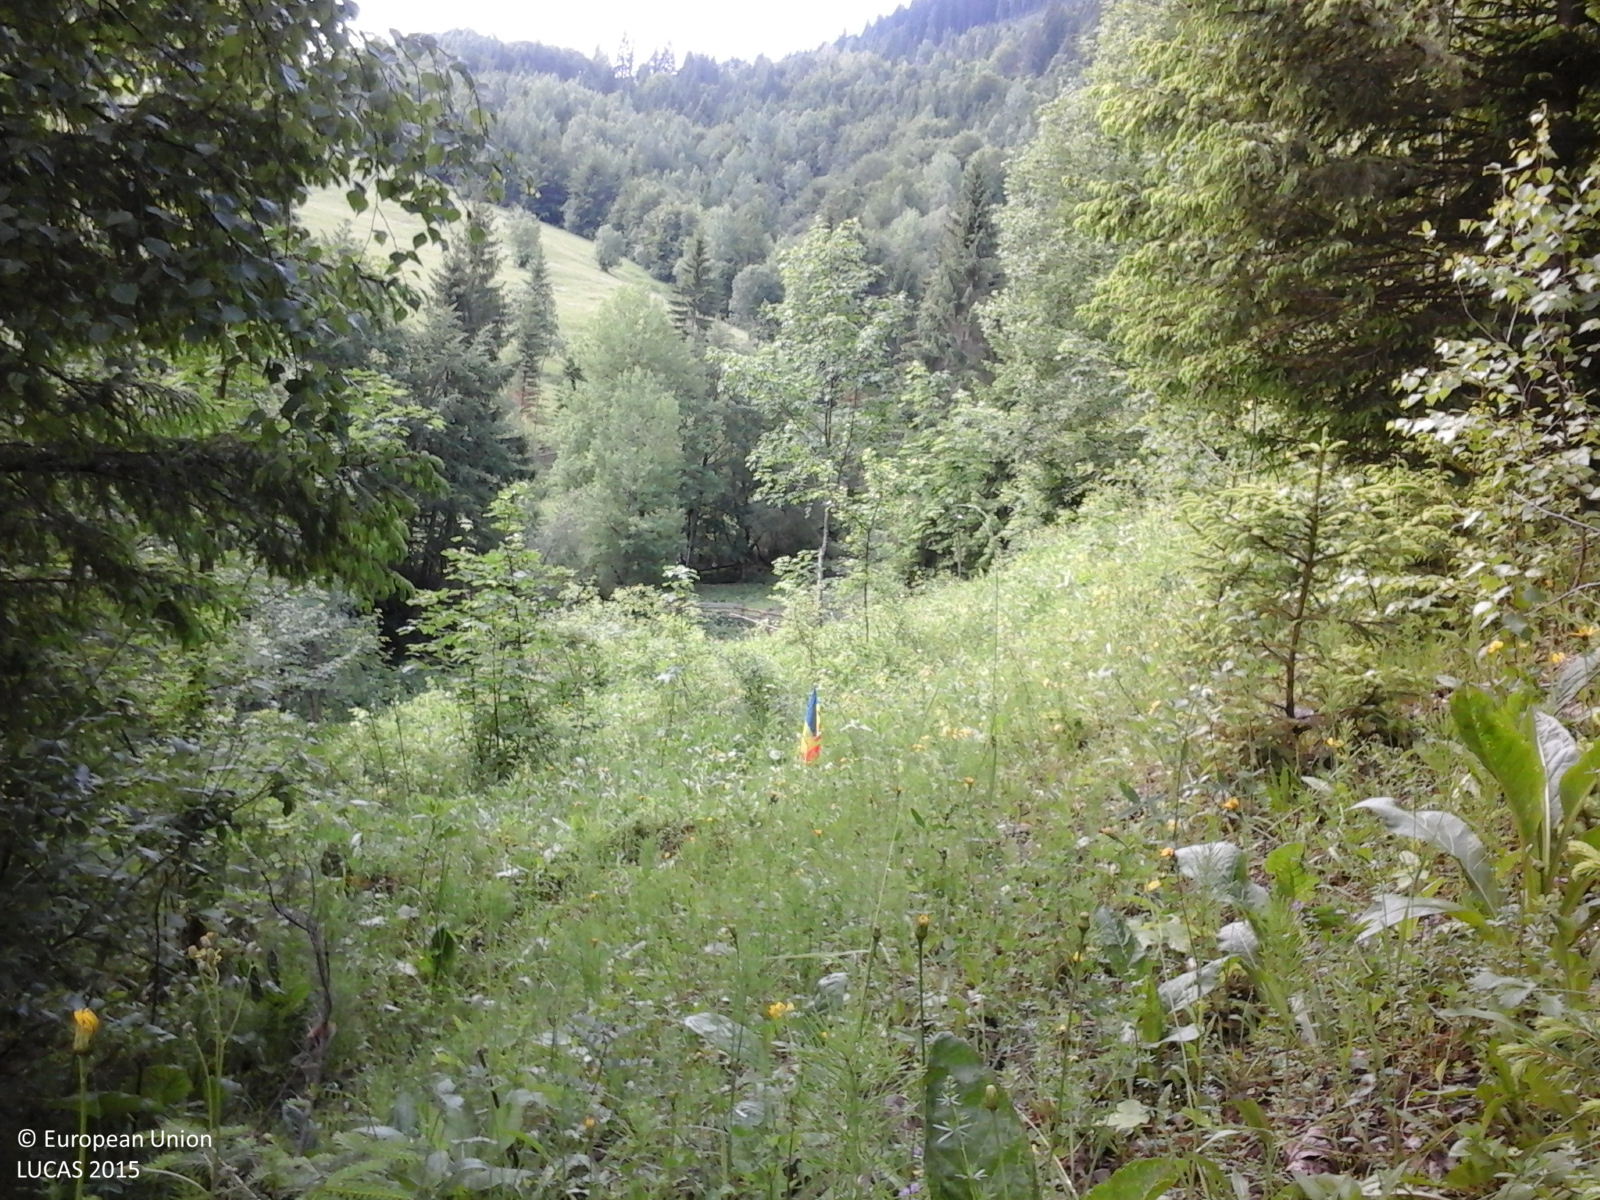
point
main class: Woodland
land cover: Broadleaved woodland
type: mountainous beech forest
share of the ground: > 75 %
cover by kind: broadleaved forest trees 80 %, coniferous forest trees 20 %
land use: Forestry
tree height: > 5 m
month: June
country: RO
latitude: 46.7900
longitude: 25.9871
